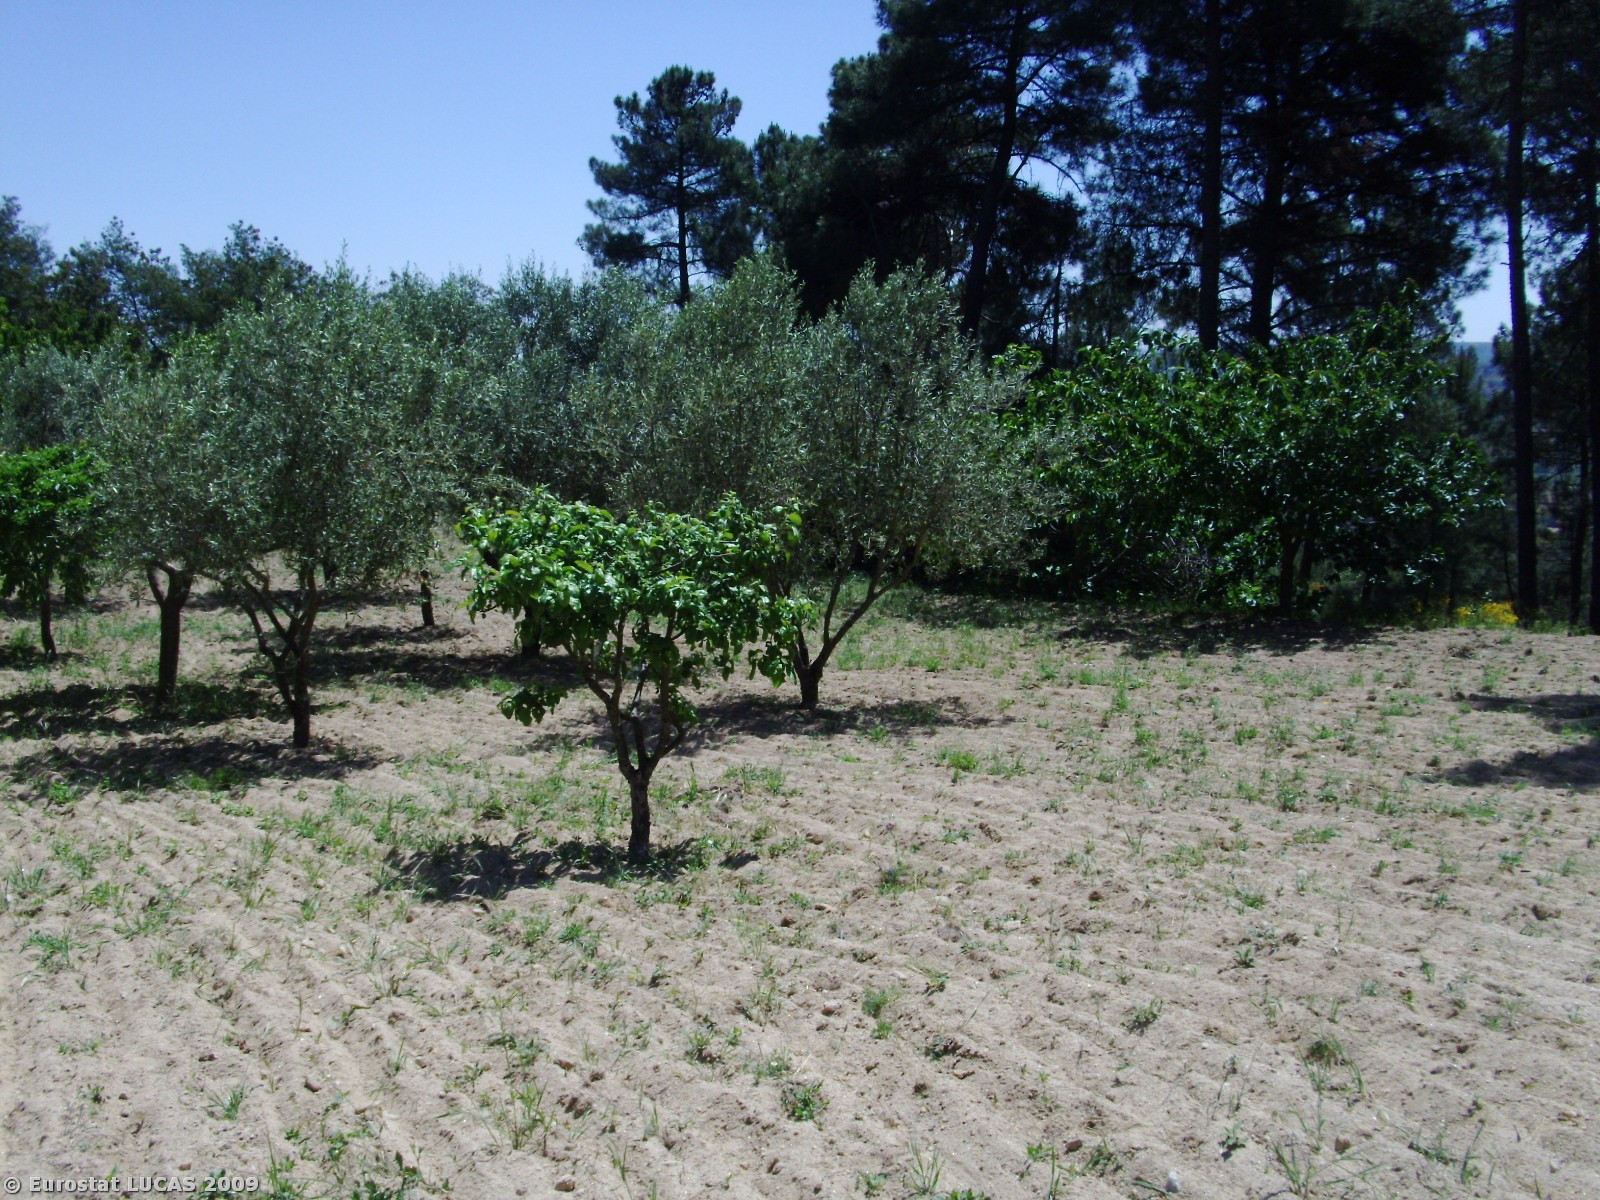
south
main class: Cropland
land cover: Olive groves
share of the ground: 50 - 75 %
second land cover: Cherry fruit
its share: 25 - 50 %
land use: Agriculture (excluding fallow land and kitchen gardens)
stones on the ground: 25 - 50 %
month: May
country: PT
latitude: 40.8176
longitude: -7.3145
